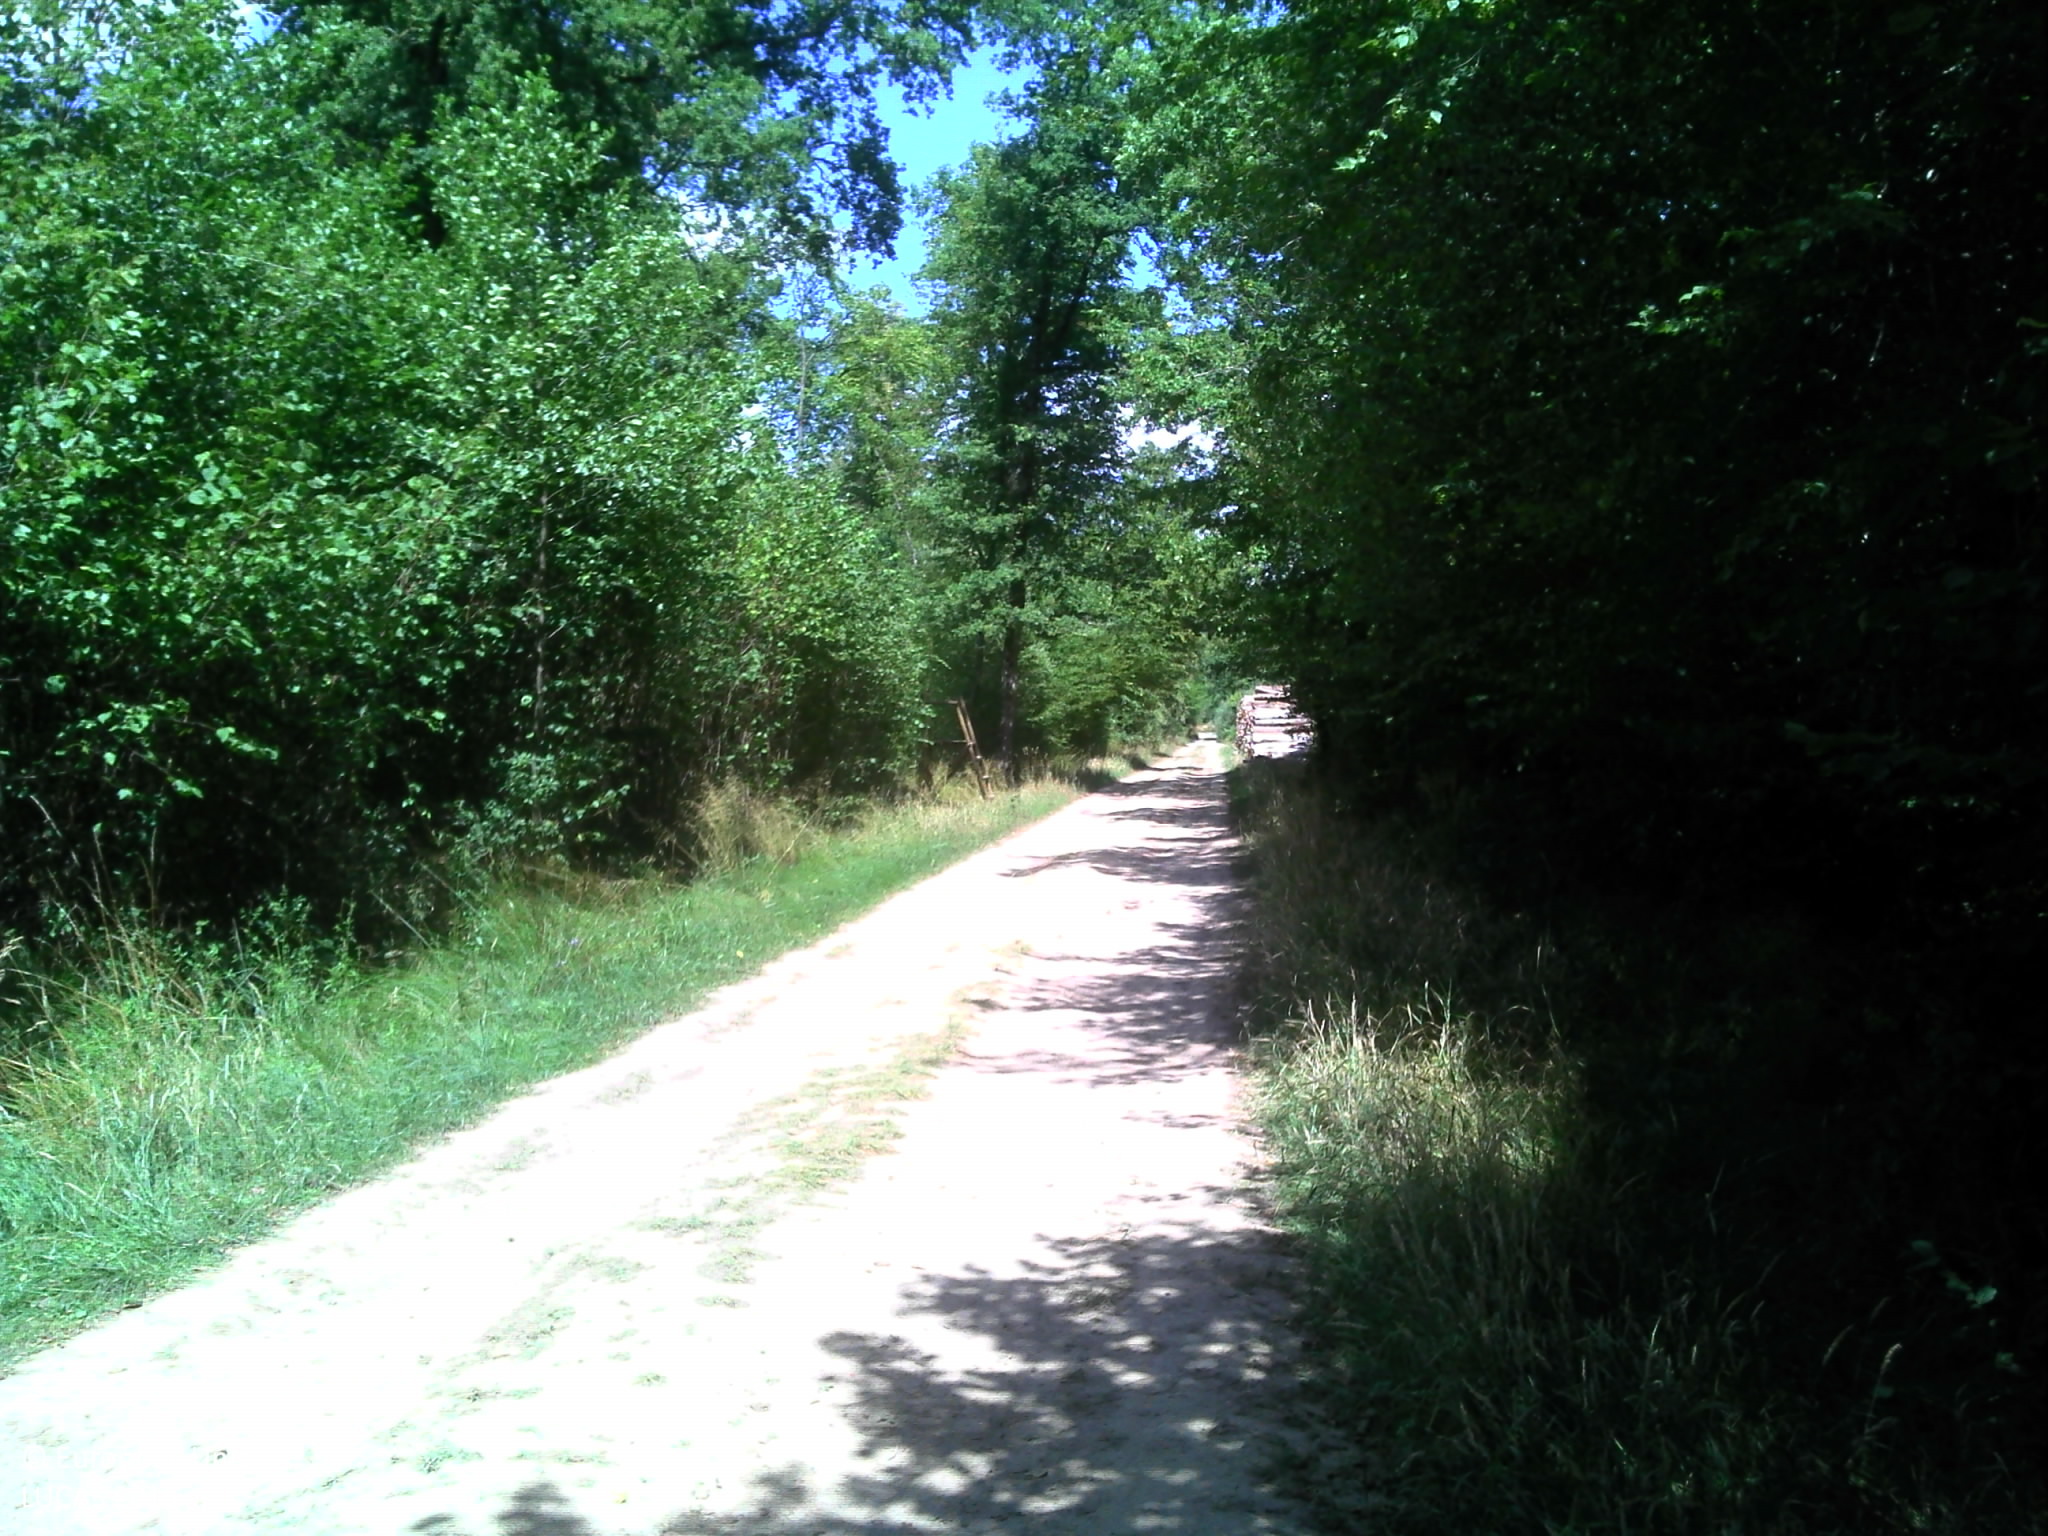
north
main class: Woodland
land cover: Broadleaved woodland
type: non-riverine alder, birch or aspen forest
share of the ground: > 75 %
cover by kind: broadleaved forest trees 80 %, herbaceous plants 20 %
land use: Forestry
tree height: > 5 m
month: July
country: FR
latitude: 46.8121
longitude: 5.0083
